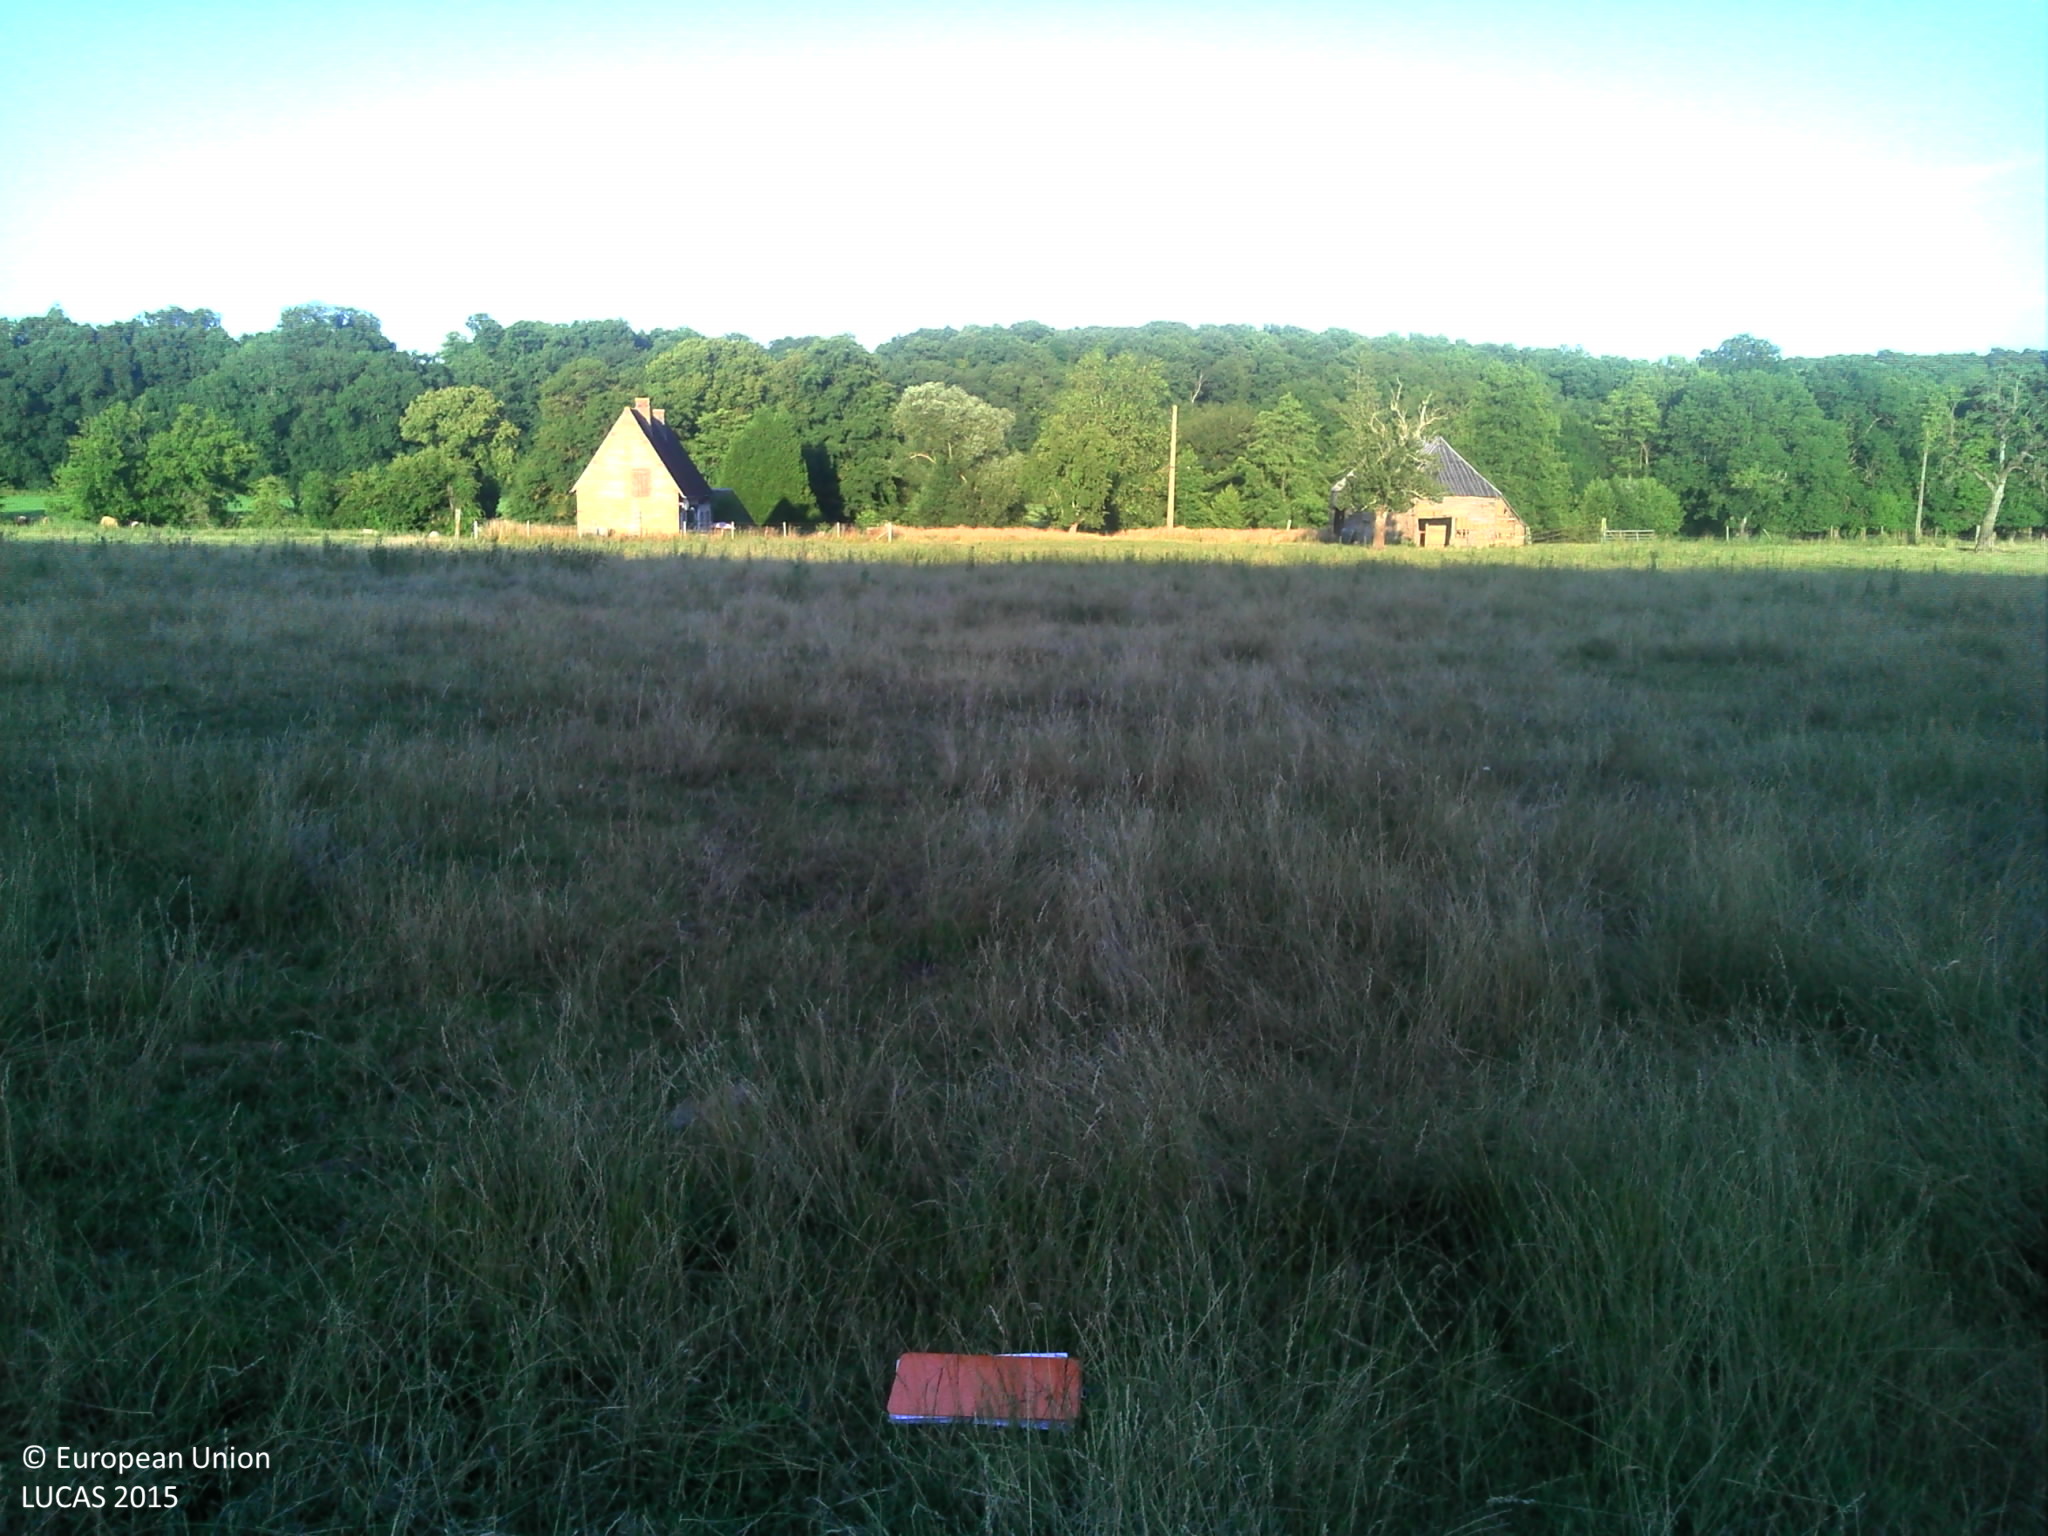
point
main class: Grassland
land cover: Grassland without tree/shrub cover
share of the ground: > 75 %
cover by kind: herbaceous plants 100 %
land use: Agriculture (excluding fallow land and kitchen gardens)
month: July
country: FR
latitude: 48.9016
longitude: 0.7408
